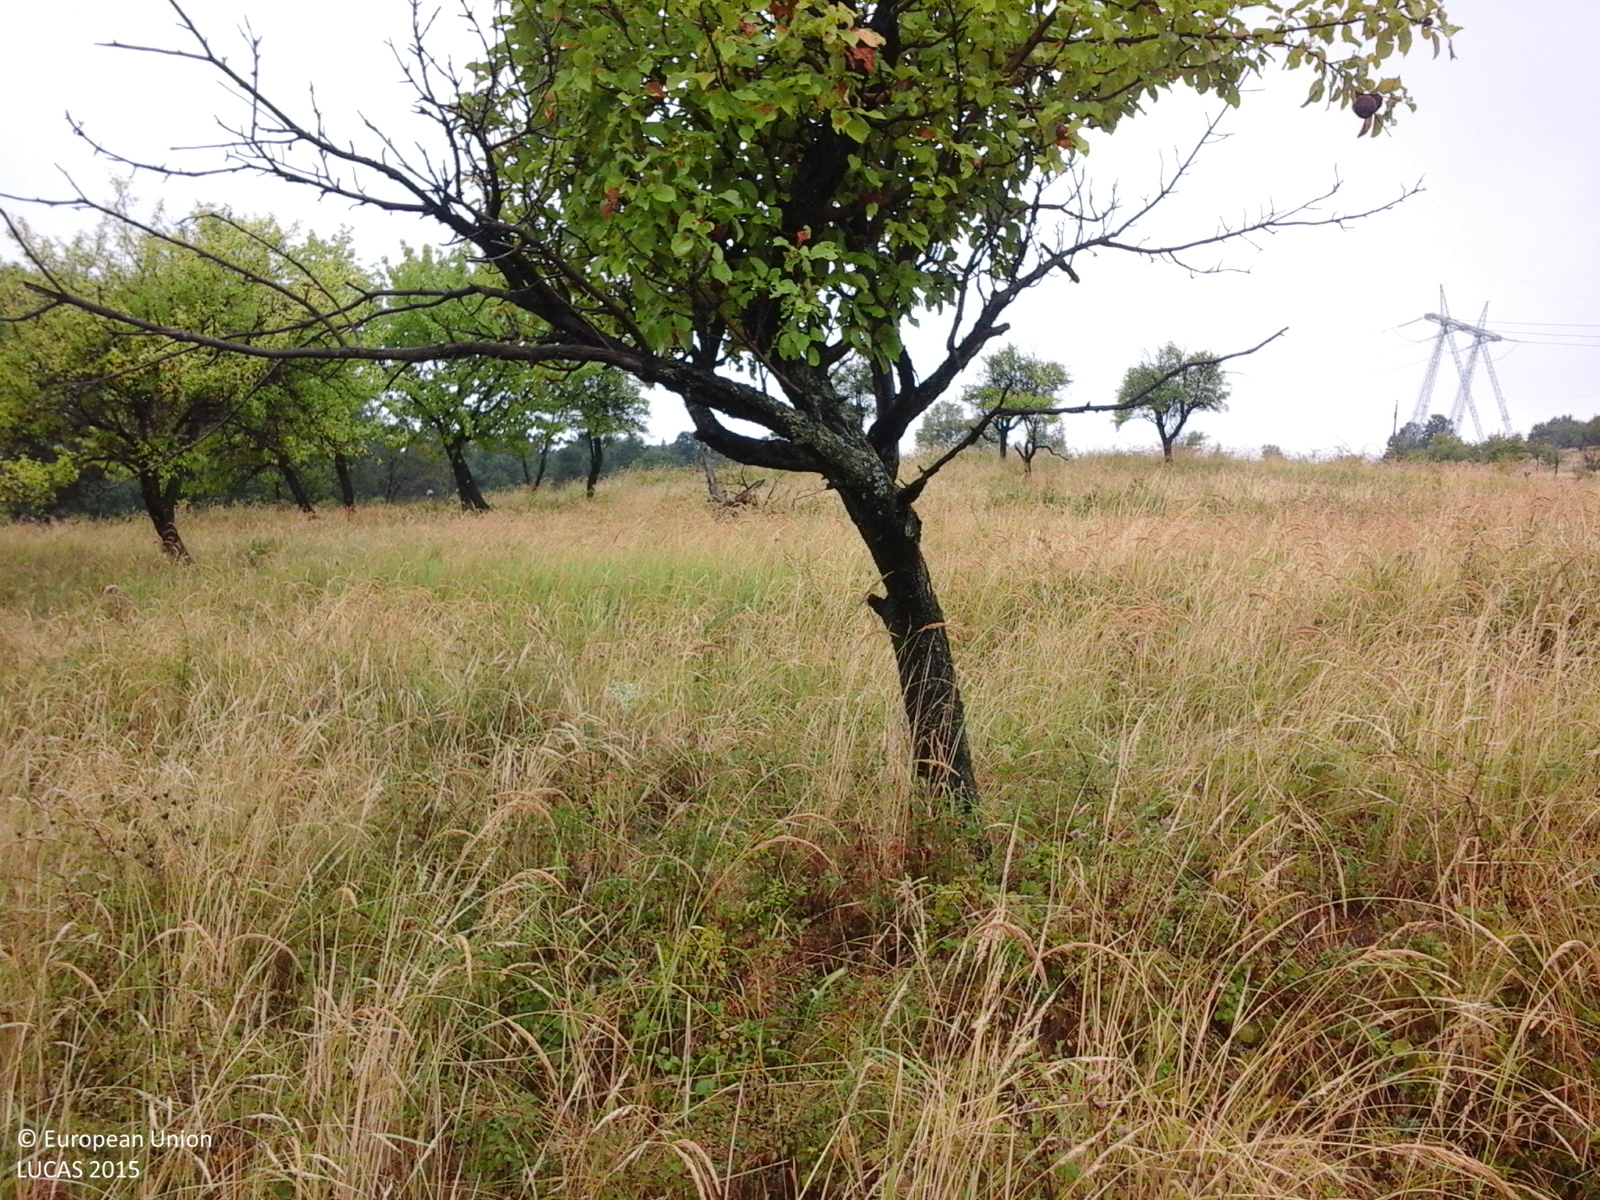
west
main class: Cropland
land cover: Apple fruit
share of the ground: > 75 %
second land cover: Spontaneously vegetated surfaces
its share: > 75 %
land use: Agriculture (excluding fallow land and kitchen gardens)
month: August
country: RO
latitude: 44.7800
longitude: 22.7703
